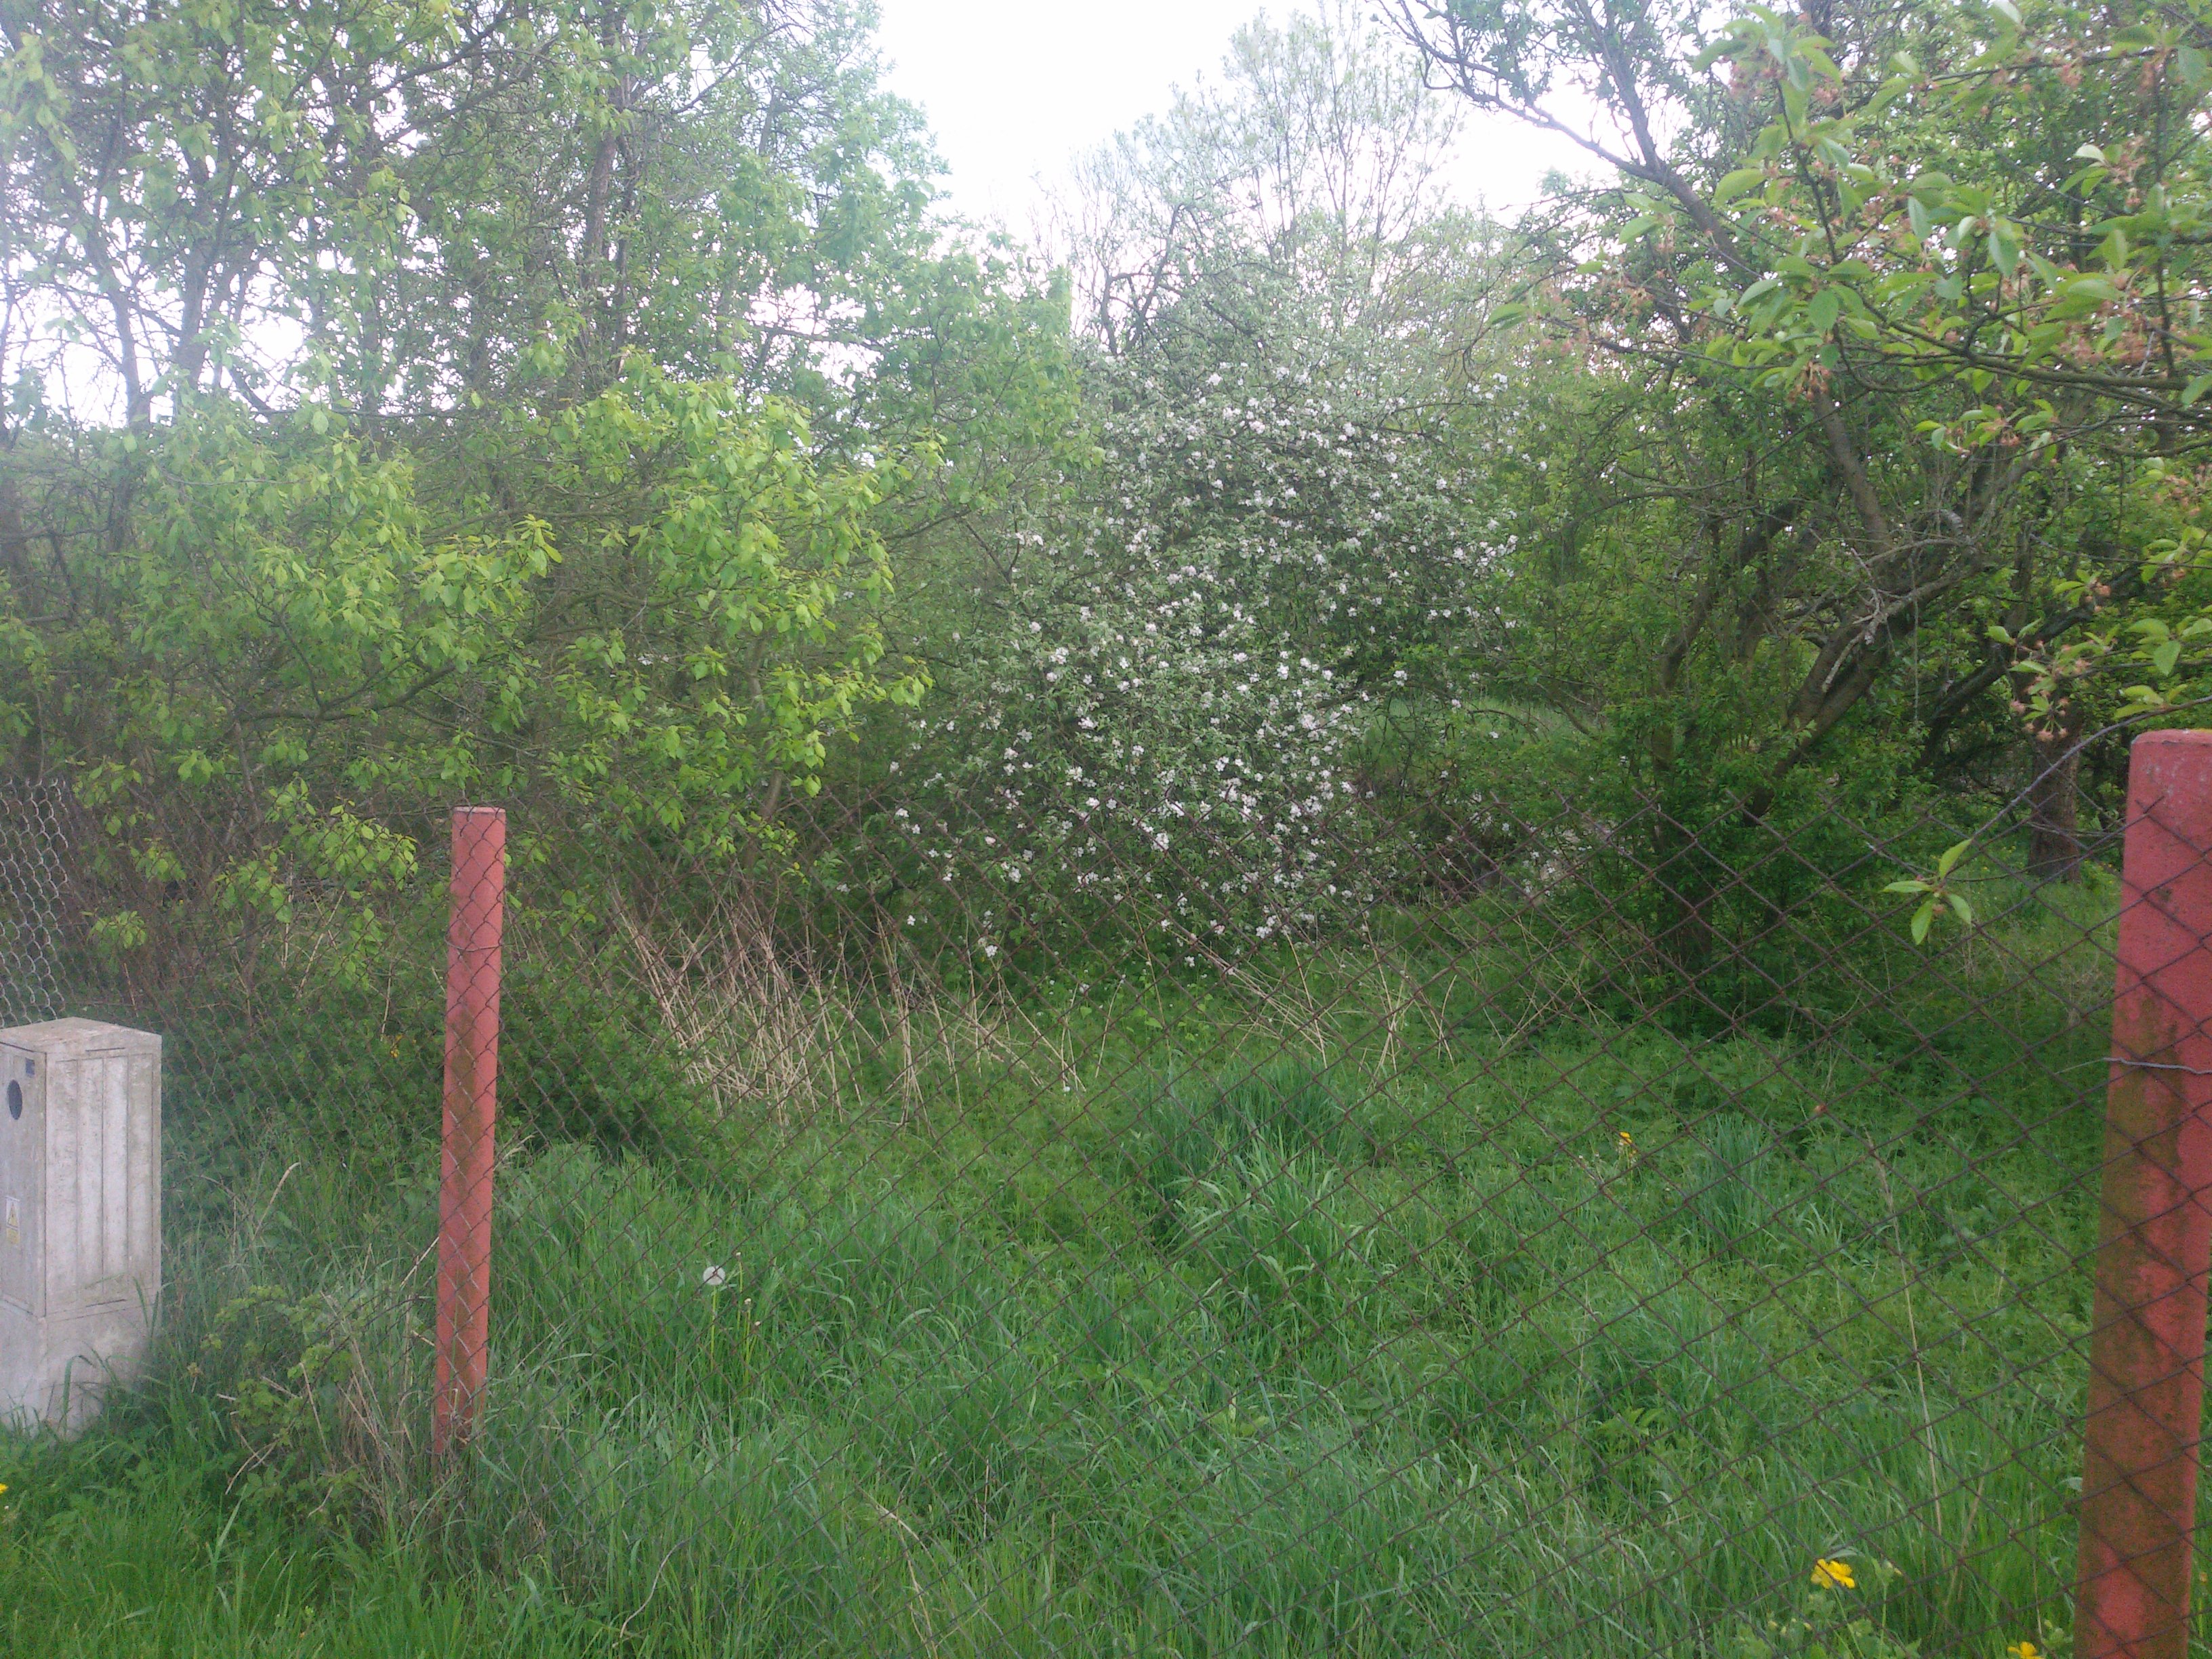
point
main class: Grassland
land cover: Grassland with sparse tree/shrub cover
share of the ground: 50 - 75 %
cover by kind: herbaceous plants 85 %, shrubs 10 %, broadleaved forest trees 5 %
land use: Residential
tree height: < 5 m
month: May
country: PL
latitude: 53.5698
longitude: 14.5160
